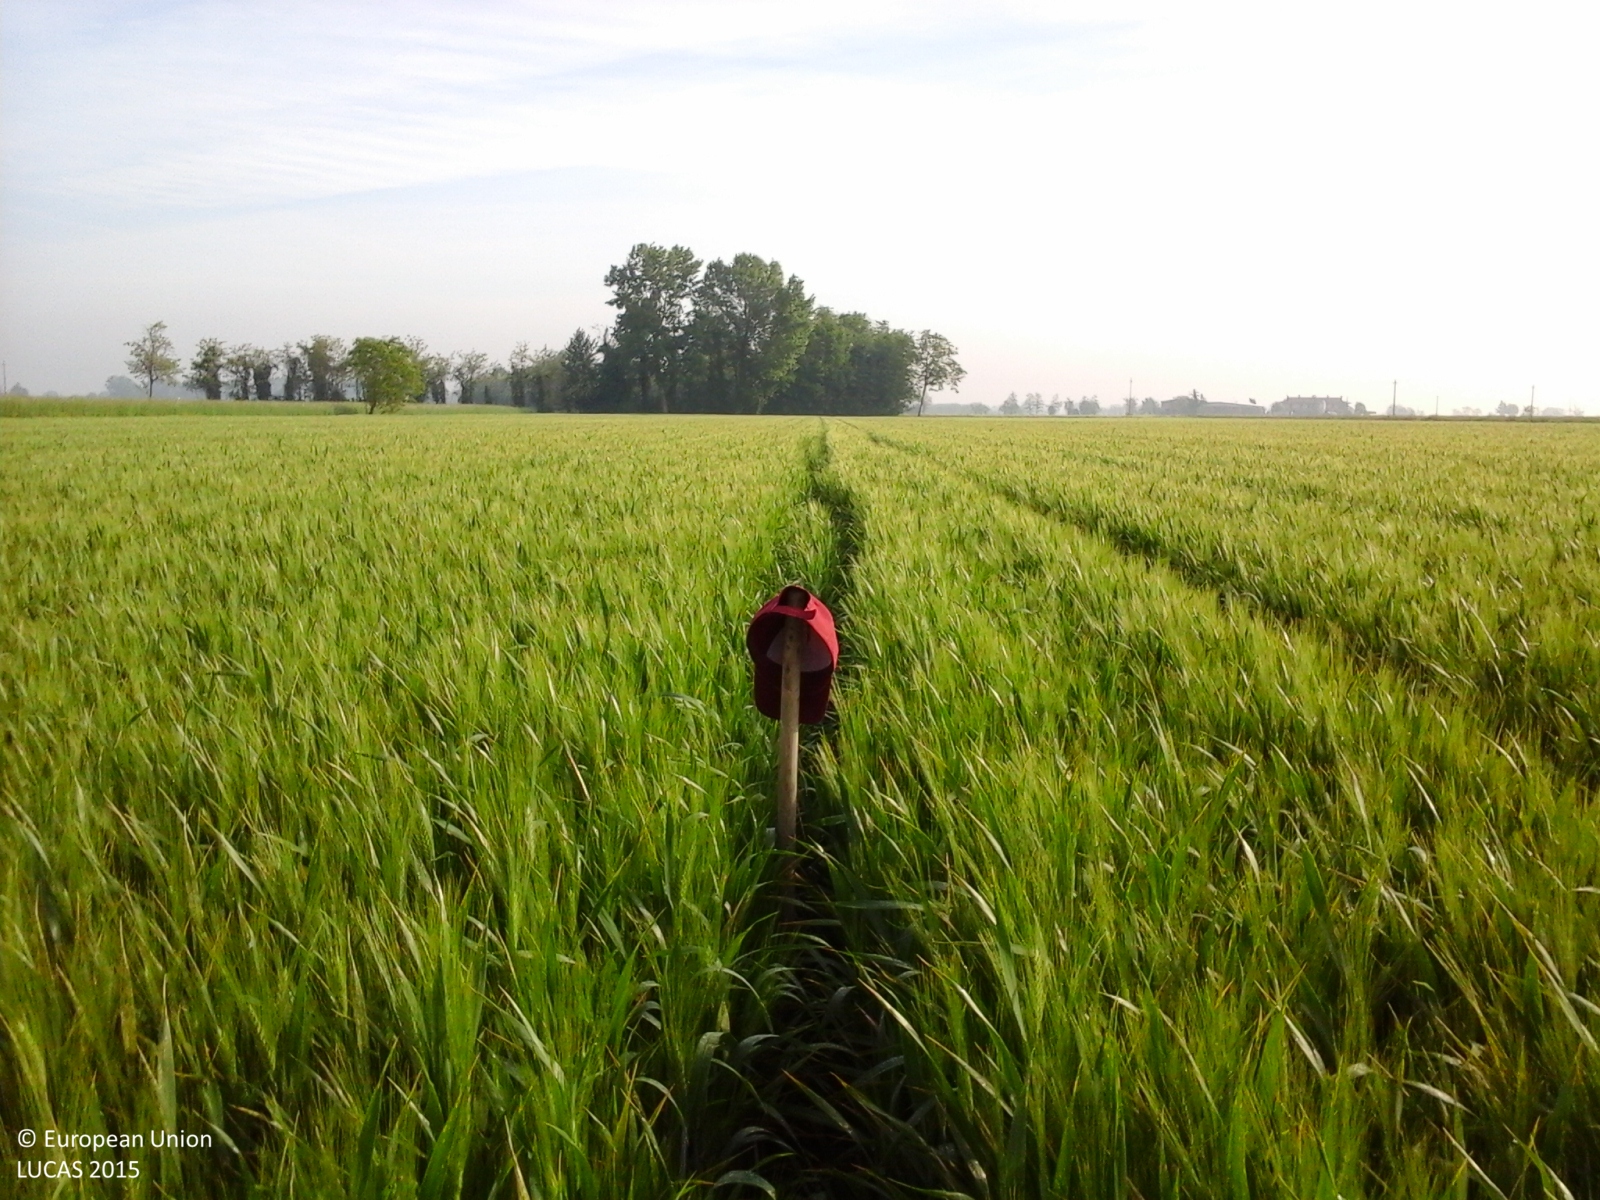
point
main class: Cropland
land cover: Common wheat
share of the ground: > 75 %
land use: Agriculture (excluding fallow land and kitchen gardens)
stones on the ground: < 10 %
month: May
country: IT
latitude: 44.9629
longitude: 9.6078
